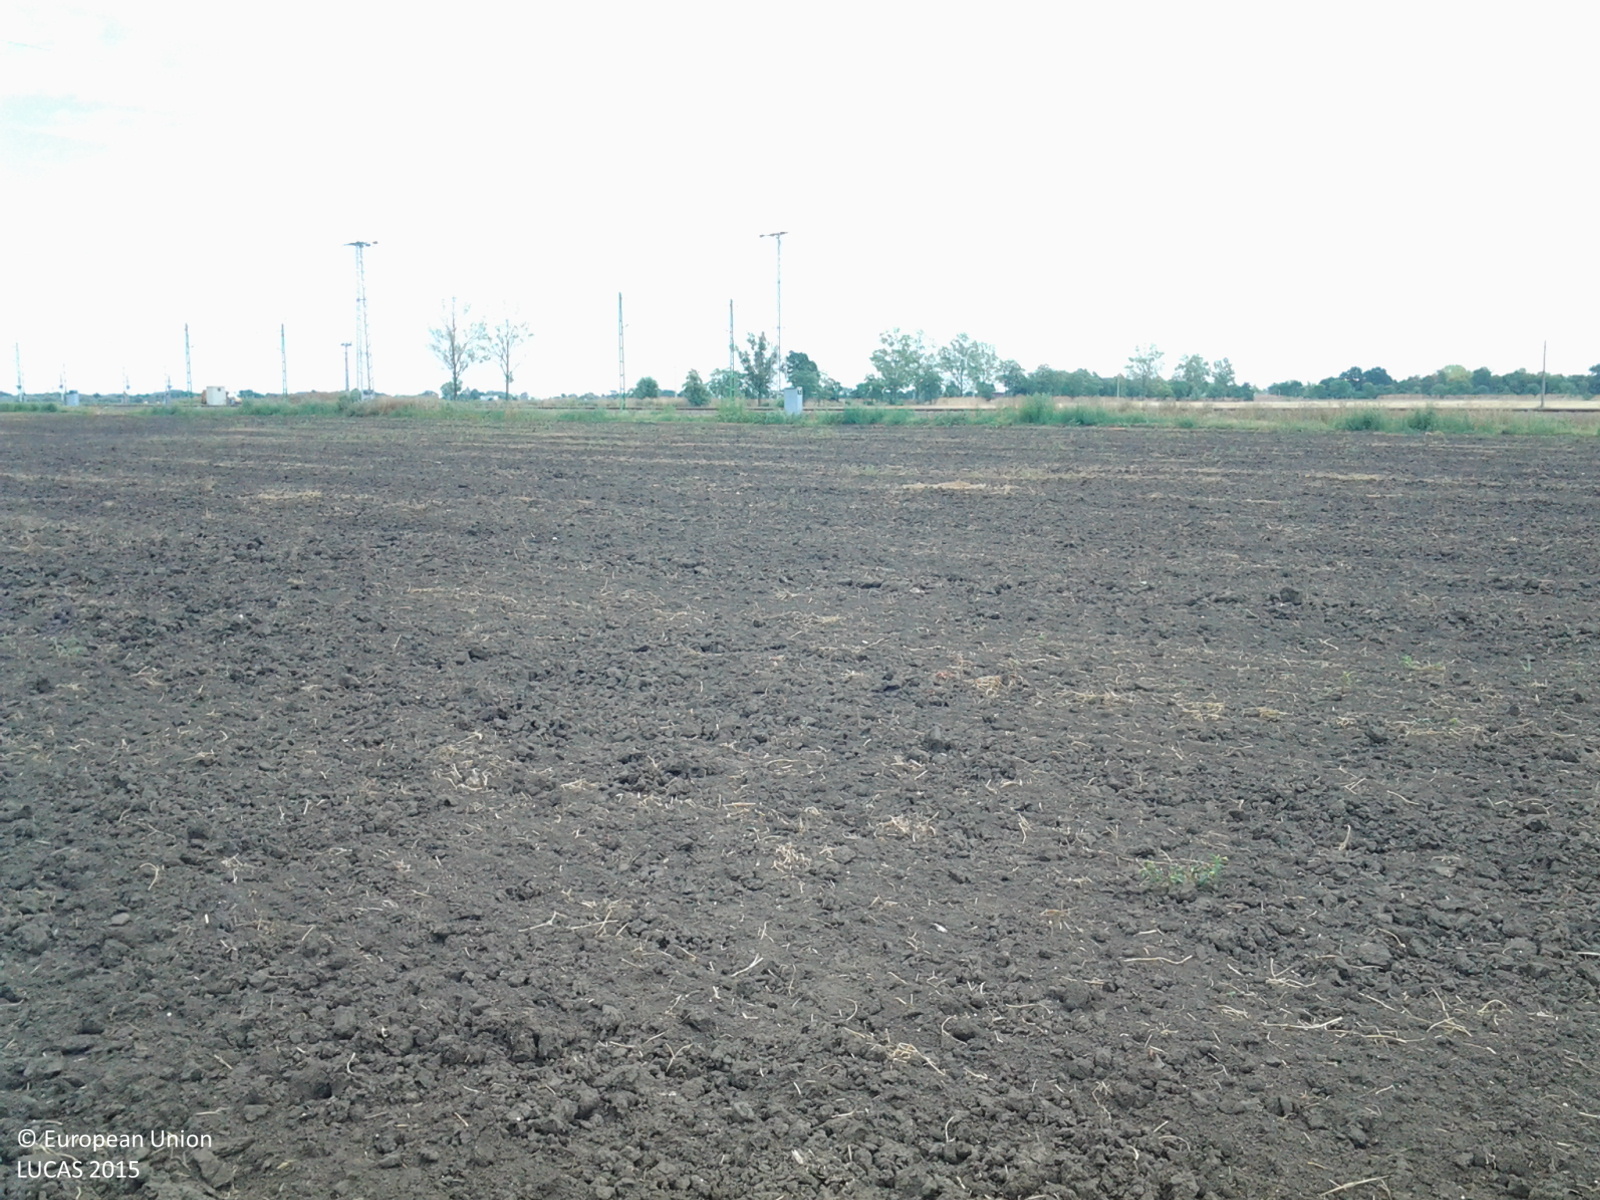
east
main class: Cropland
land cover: Dry pulses
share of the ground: < 10 %
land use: Agriculture (excluding fallow land and kitchen gardens)
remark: Harvested field
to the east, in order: Dry pulses; Electric lines; Dry pulses; Grassland without tree/shrub cover; Railways; Electric lines; Grassland without tree/shrub cover; Tracks; Common wheat
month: July
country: HU
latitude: 47.2830
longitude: 20.8888
